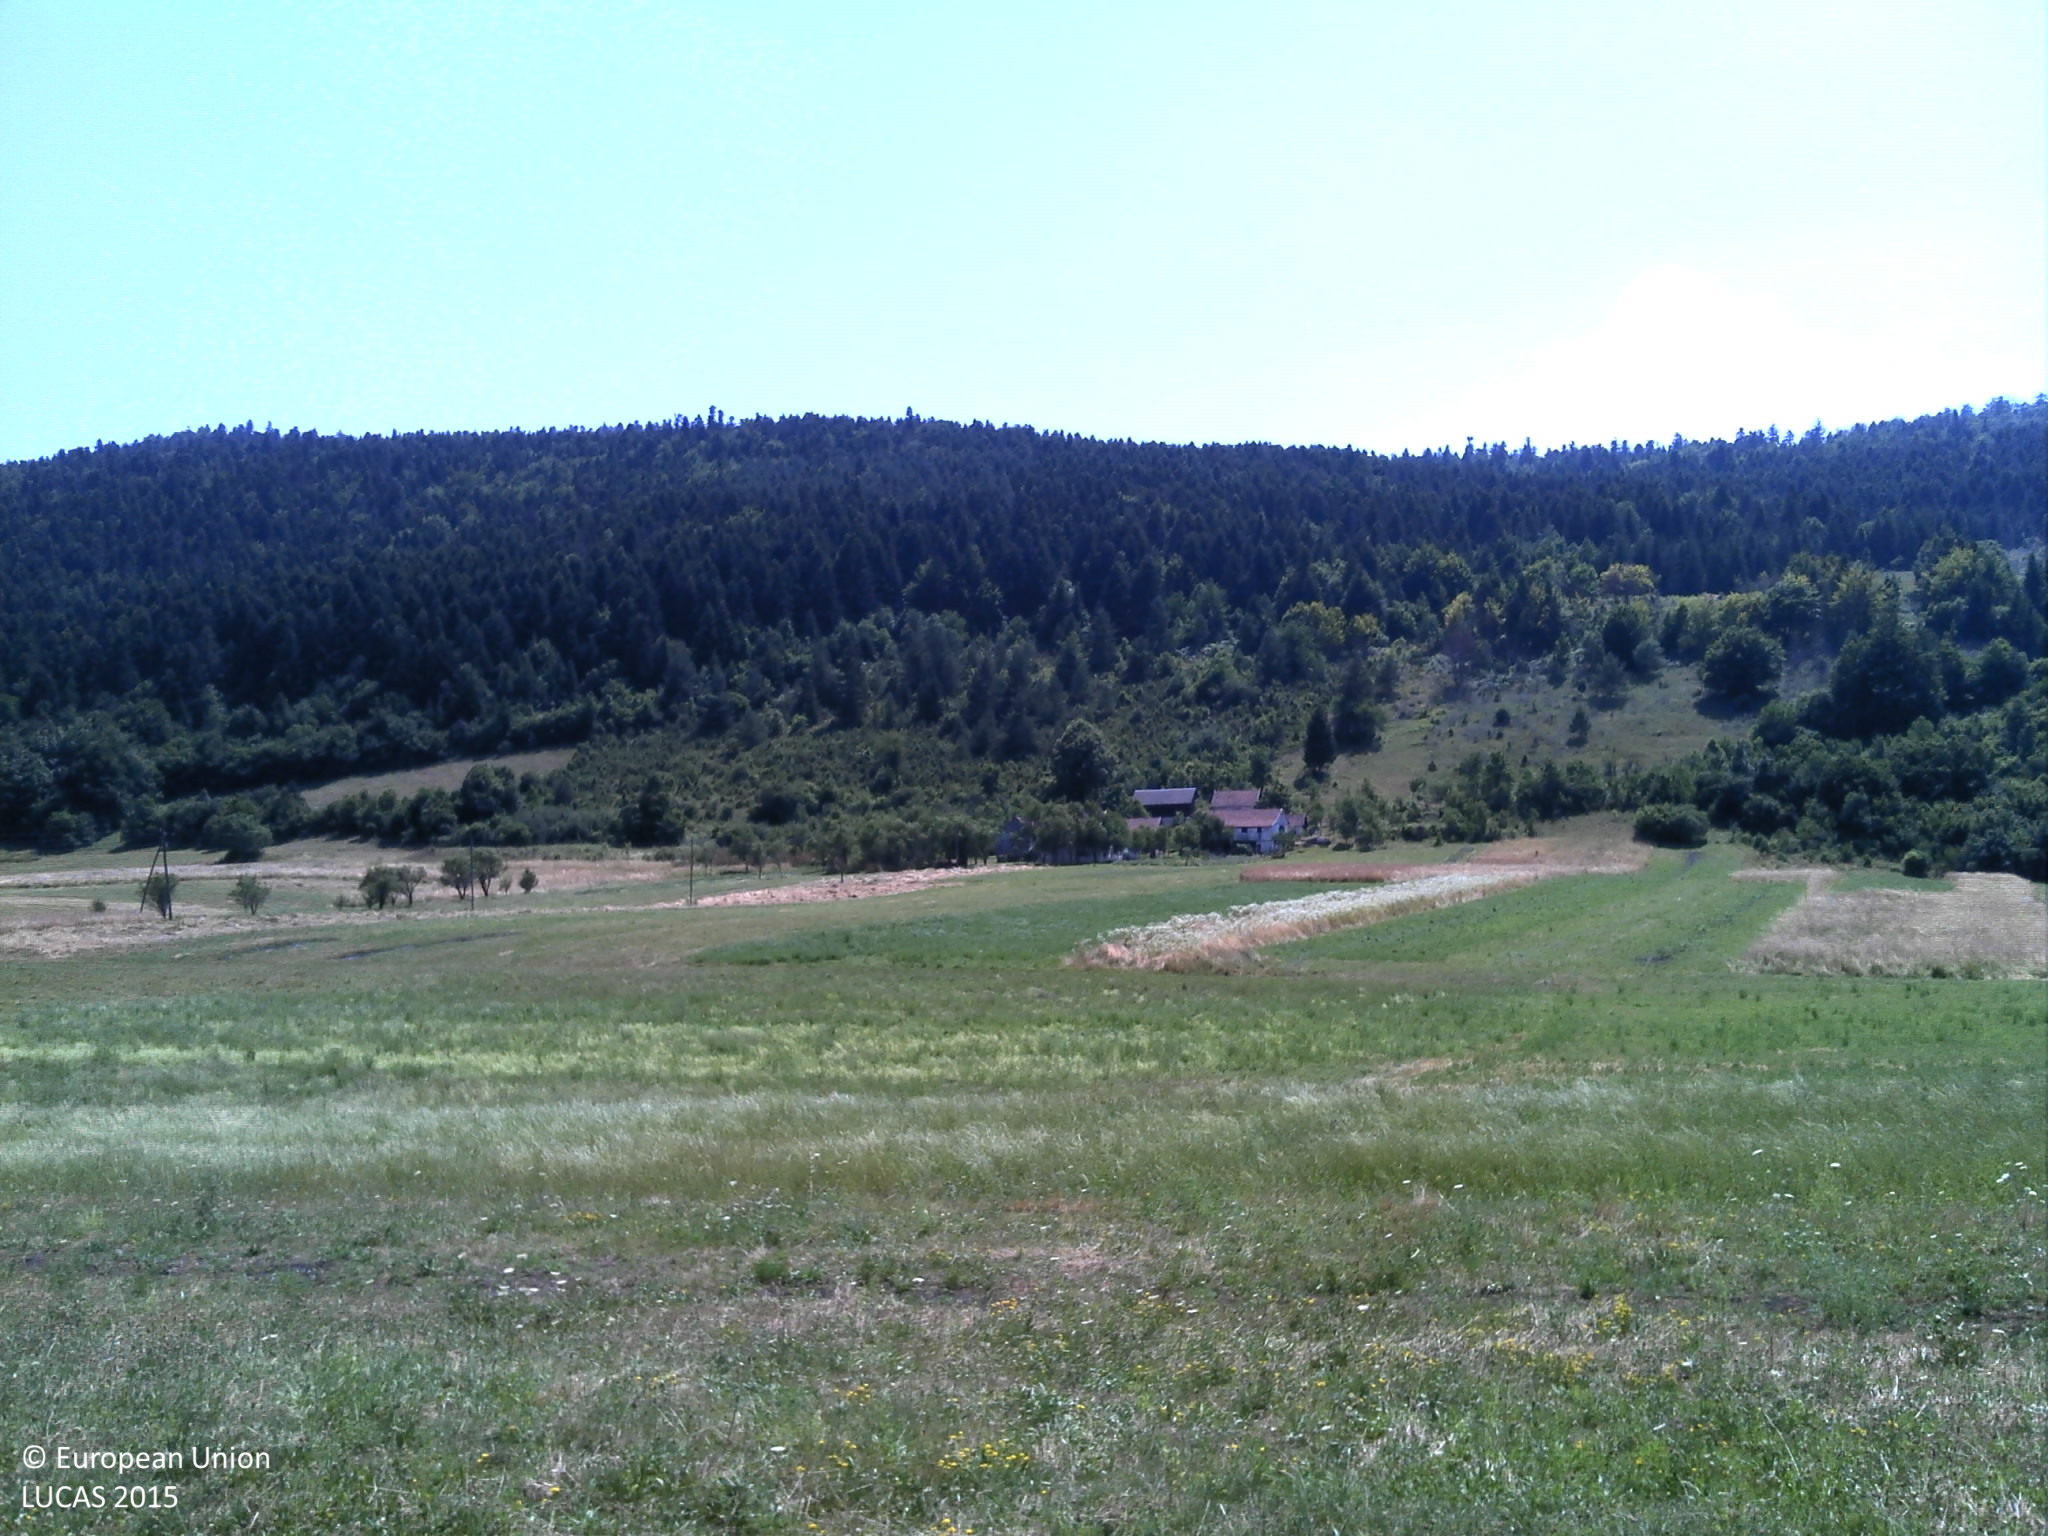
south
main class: Grassland
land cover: Grassland without tree/shrub cover
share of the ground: > 75 %
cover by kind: herbaceous plants 100 %
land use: Agriculture (excluding fallow land and kitchen gardens)
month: July
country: HR
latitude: 44.9774
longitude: 15.2317
